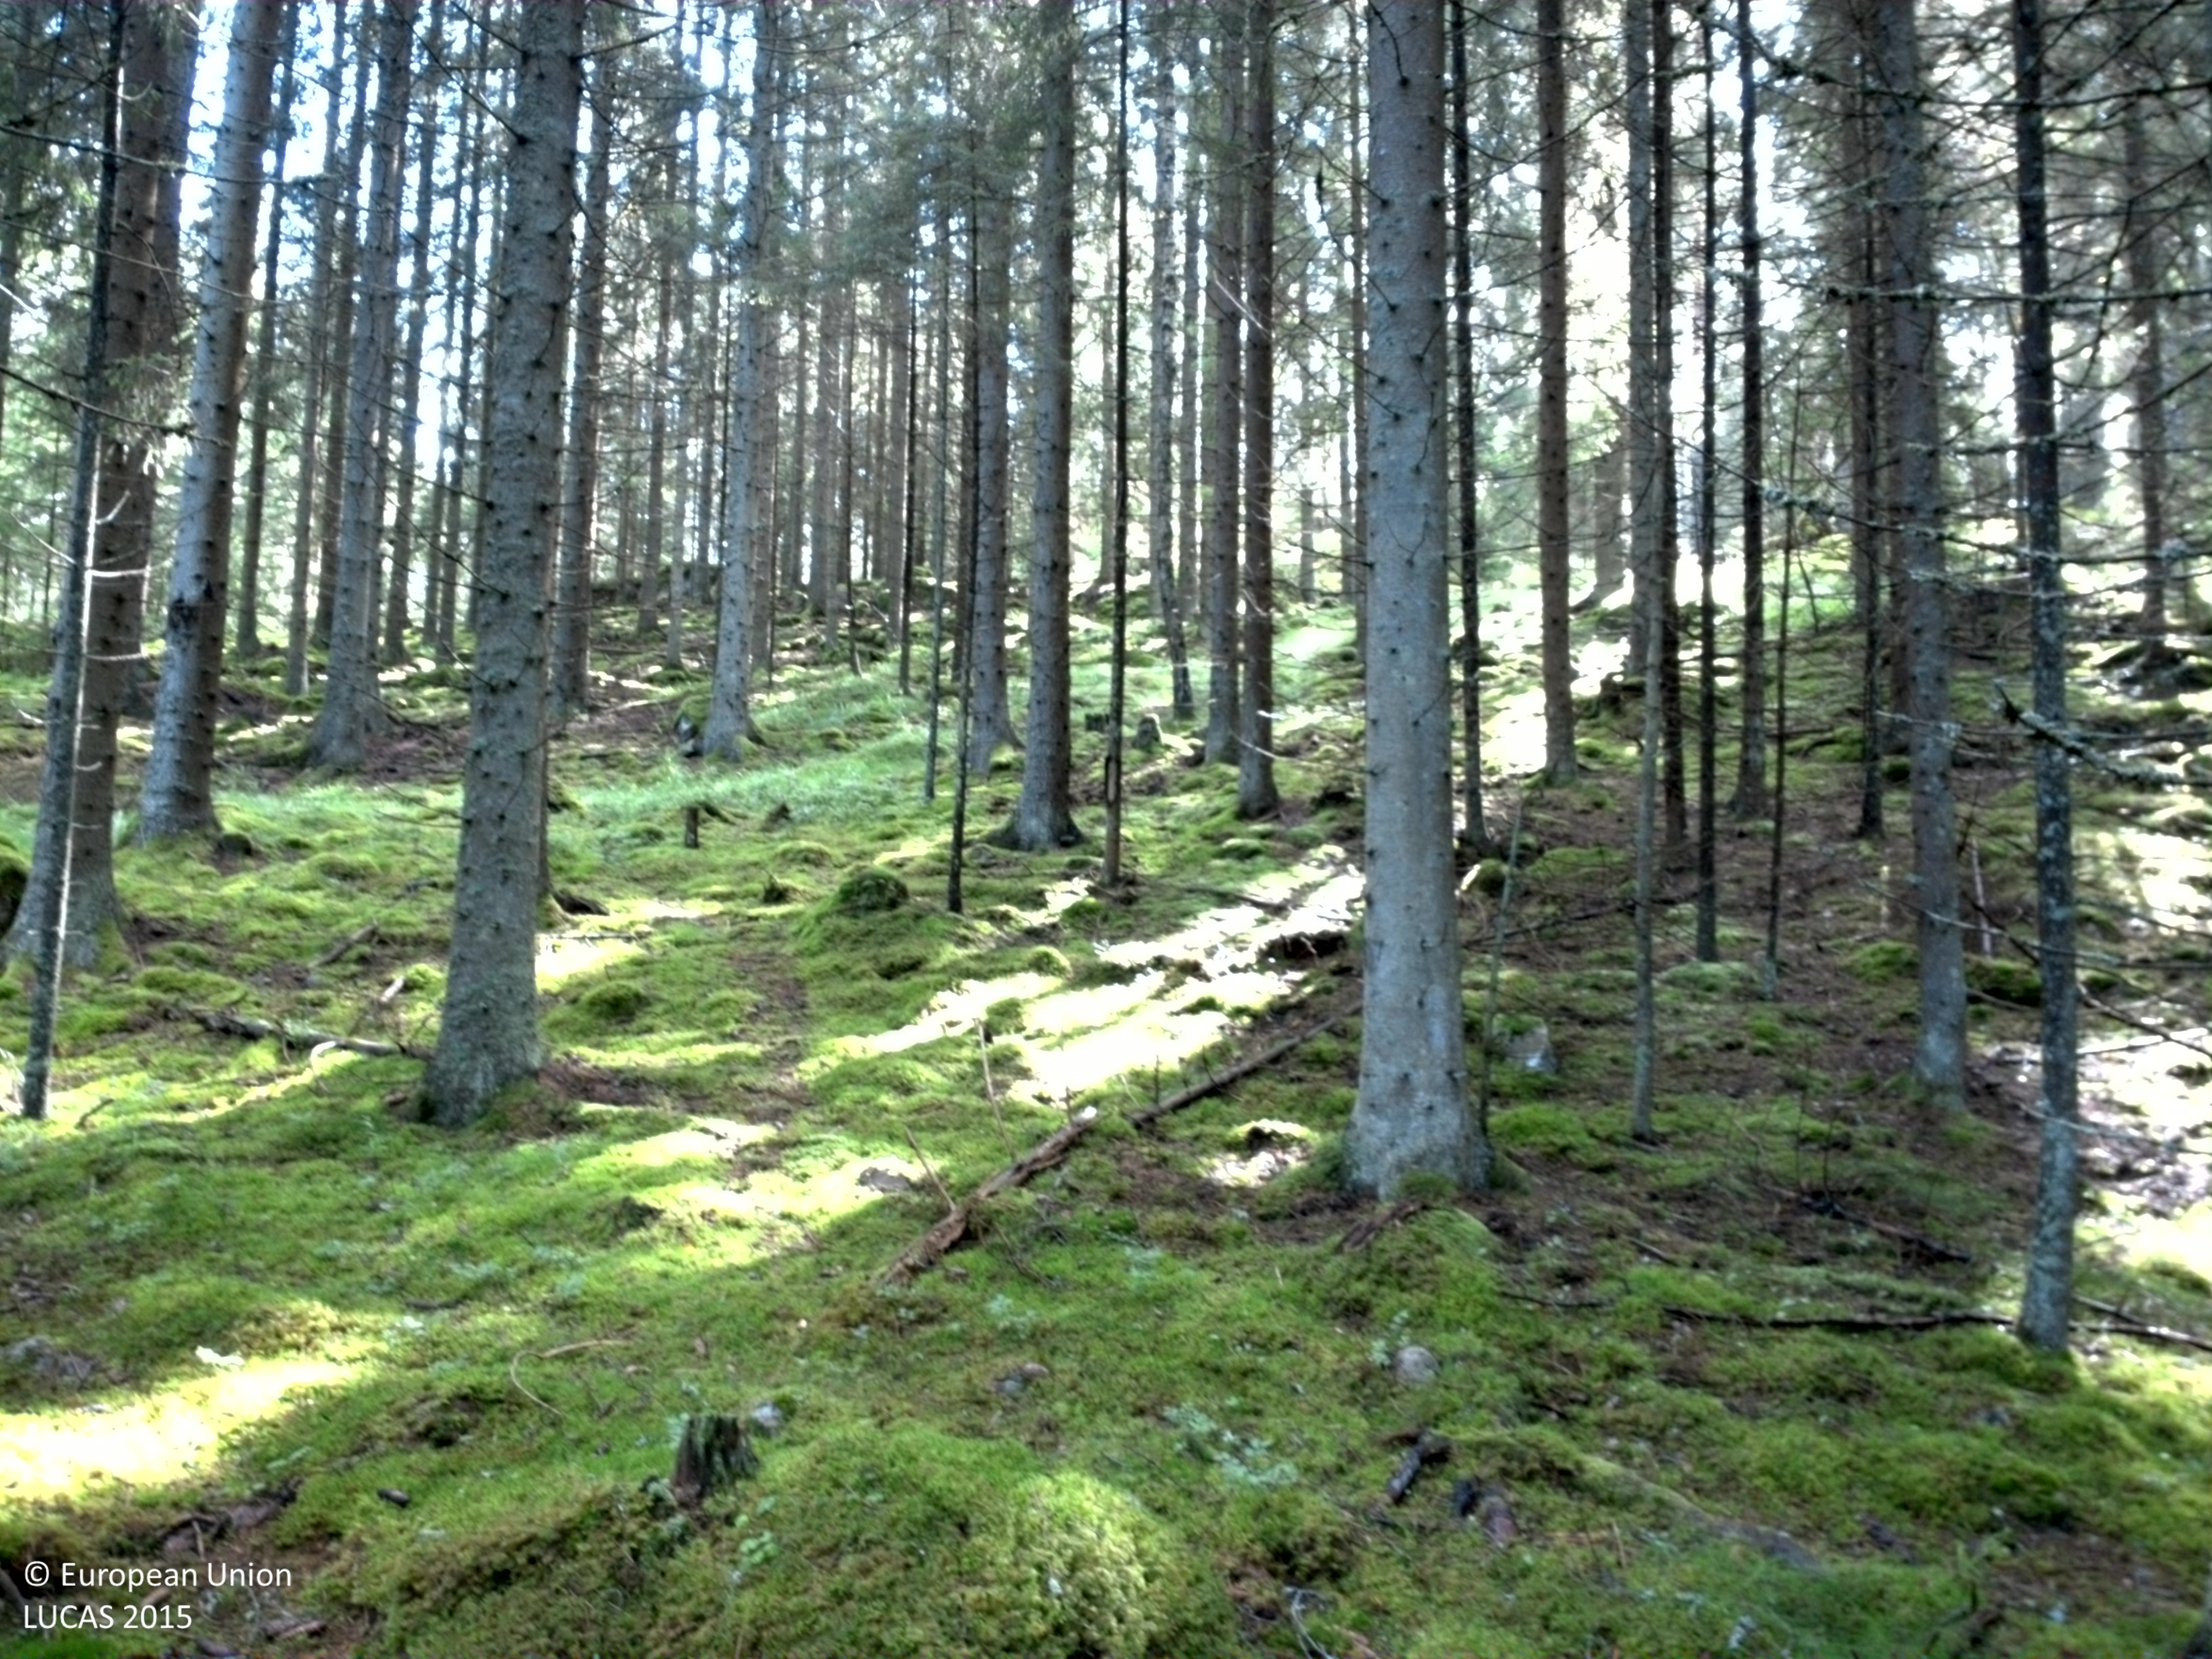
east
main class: Woodland
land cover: Spruce dominated coniferous woodland
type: boreal forest
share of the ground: 25 - 50 %
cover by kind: coniferous forest trees 40 %, lichens and mosses 35 %, herbaceous plants 25 %
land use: Forestry
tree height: > 5 m
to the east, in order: Spruce dominated coniferous woodland; Tracks; Spruce dominated coniferous woodland; Pine dominated mixed woodland; Lichens and moss; Pine dominated mixed woodland
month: July
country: SE
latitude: 58.7460
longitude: 15.7481
